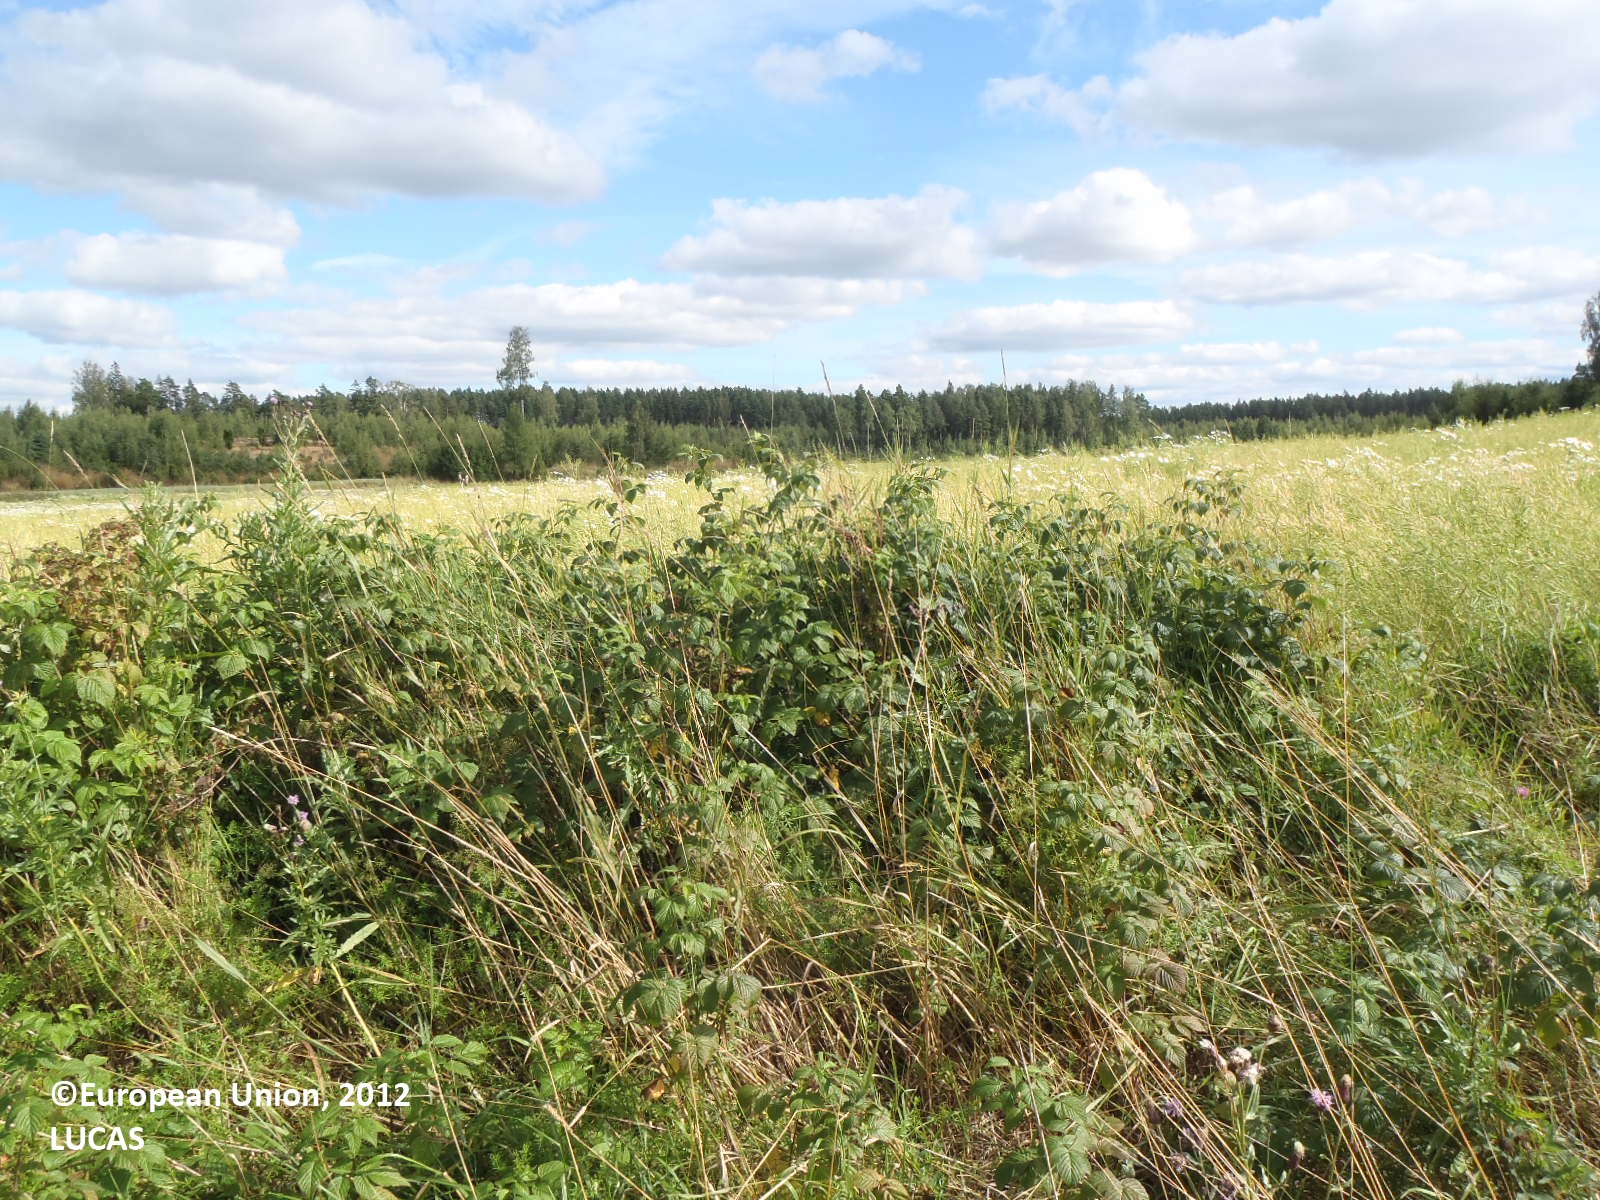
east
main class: Cropland
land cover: Rape and turnip rape
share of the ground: > 75 %
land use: Agriculture (excluding fallow land and kitchen gardens)
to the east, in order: Rape and turnip rape; Grass margins; Ditches and canals; Shrubland without tree cover; Rape and turnip rape; Grass margins; Ditches and canals; Grass margins; Oats; Grass margins; Ditches and canals; Pine dominated mixed woodland
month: August
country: FI
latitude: 60.3360
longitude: 22.4791
